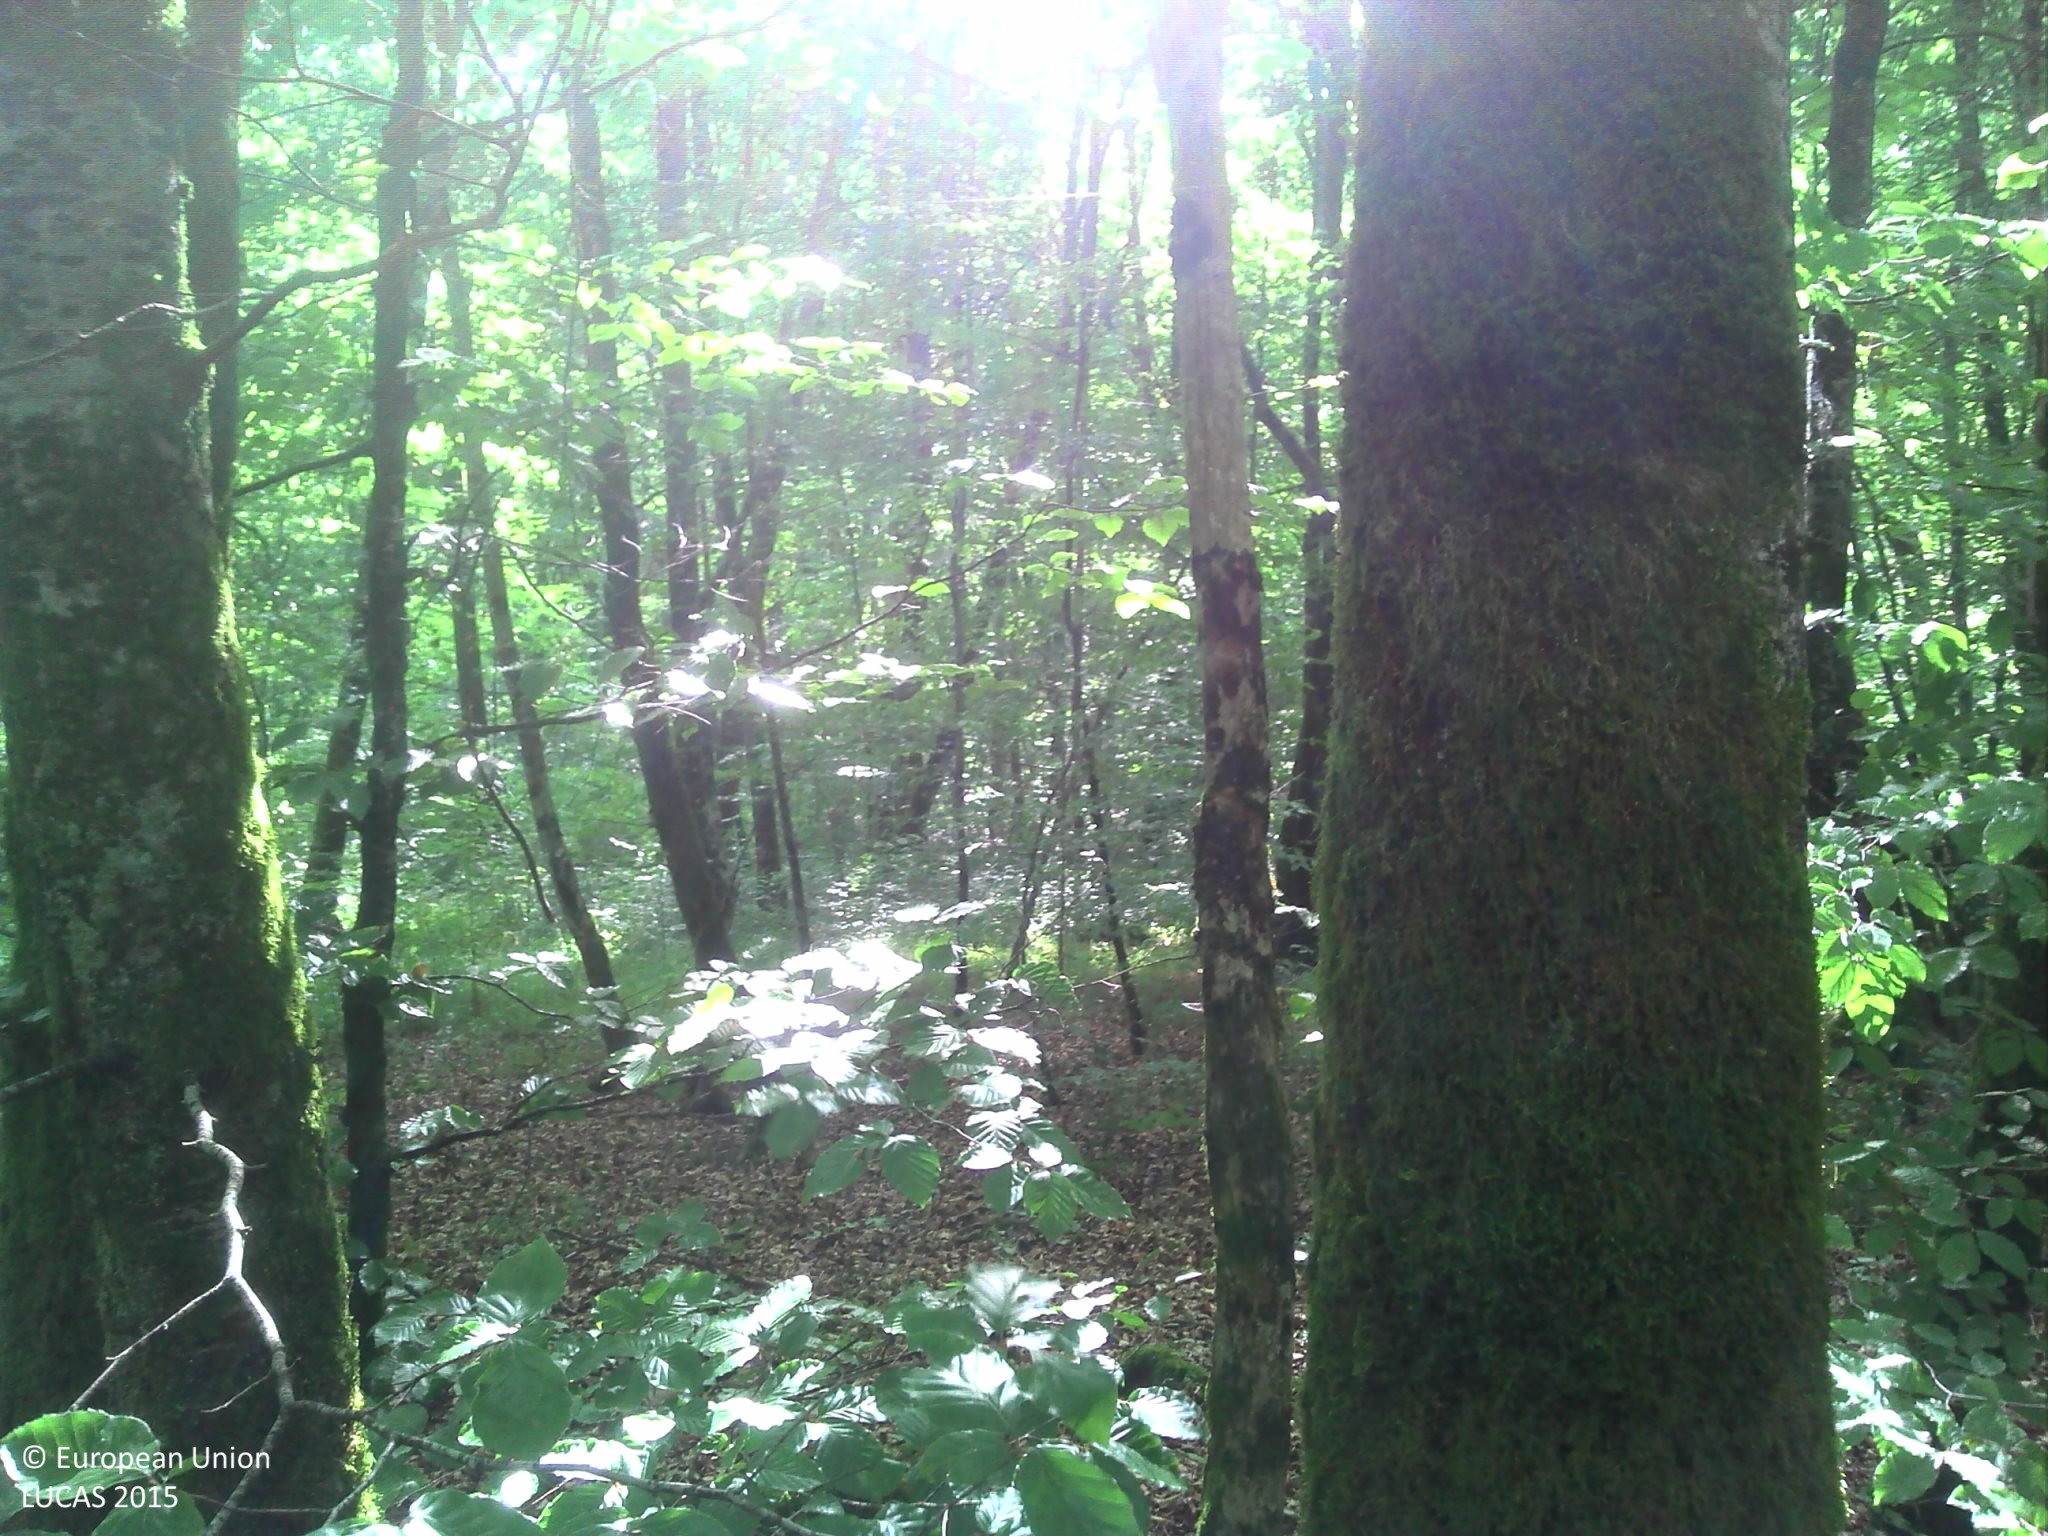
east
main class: Woodland
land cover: Broadleaved woodland
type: acidophilous oak and oak-birch forest
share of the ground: > 75 %
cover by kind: broadleaved forest trees 80 %, herbaceous plants 10 %, lichens and mosses 10 %
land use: Forestry
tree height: > 5 m
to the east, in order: Broadleaved woodland
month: July
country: FR
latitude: 47.9685
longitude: 5.0568
